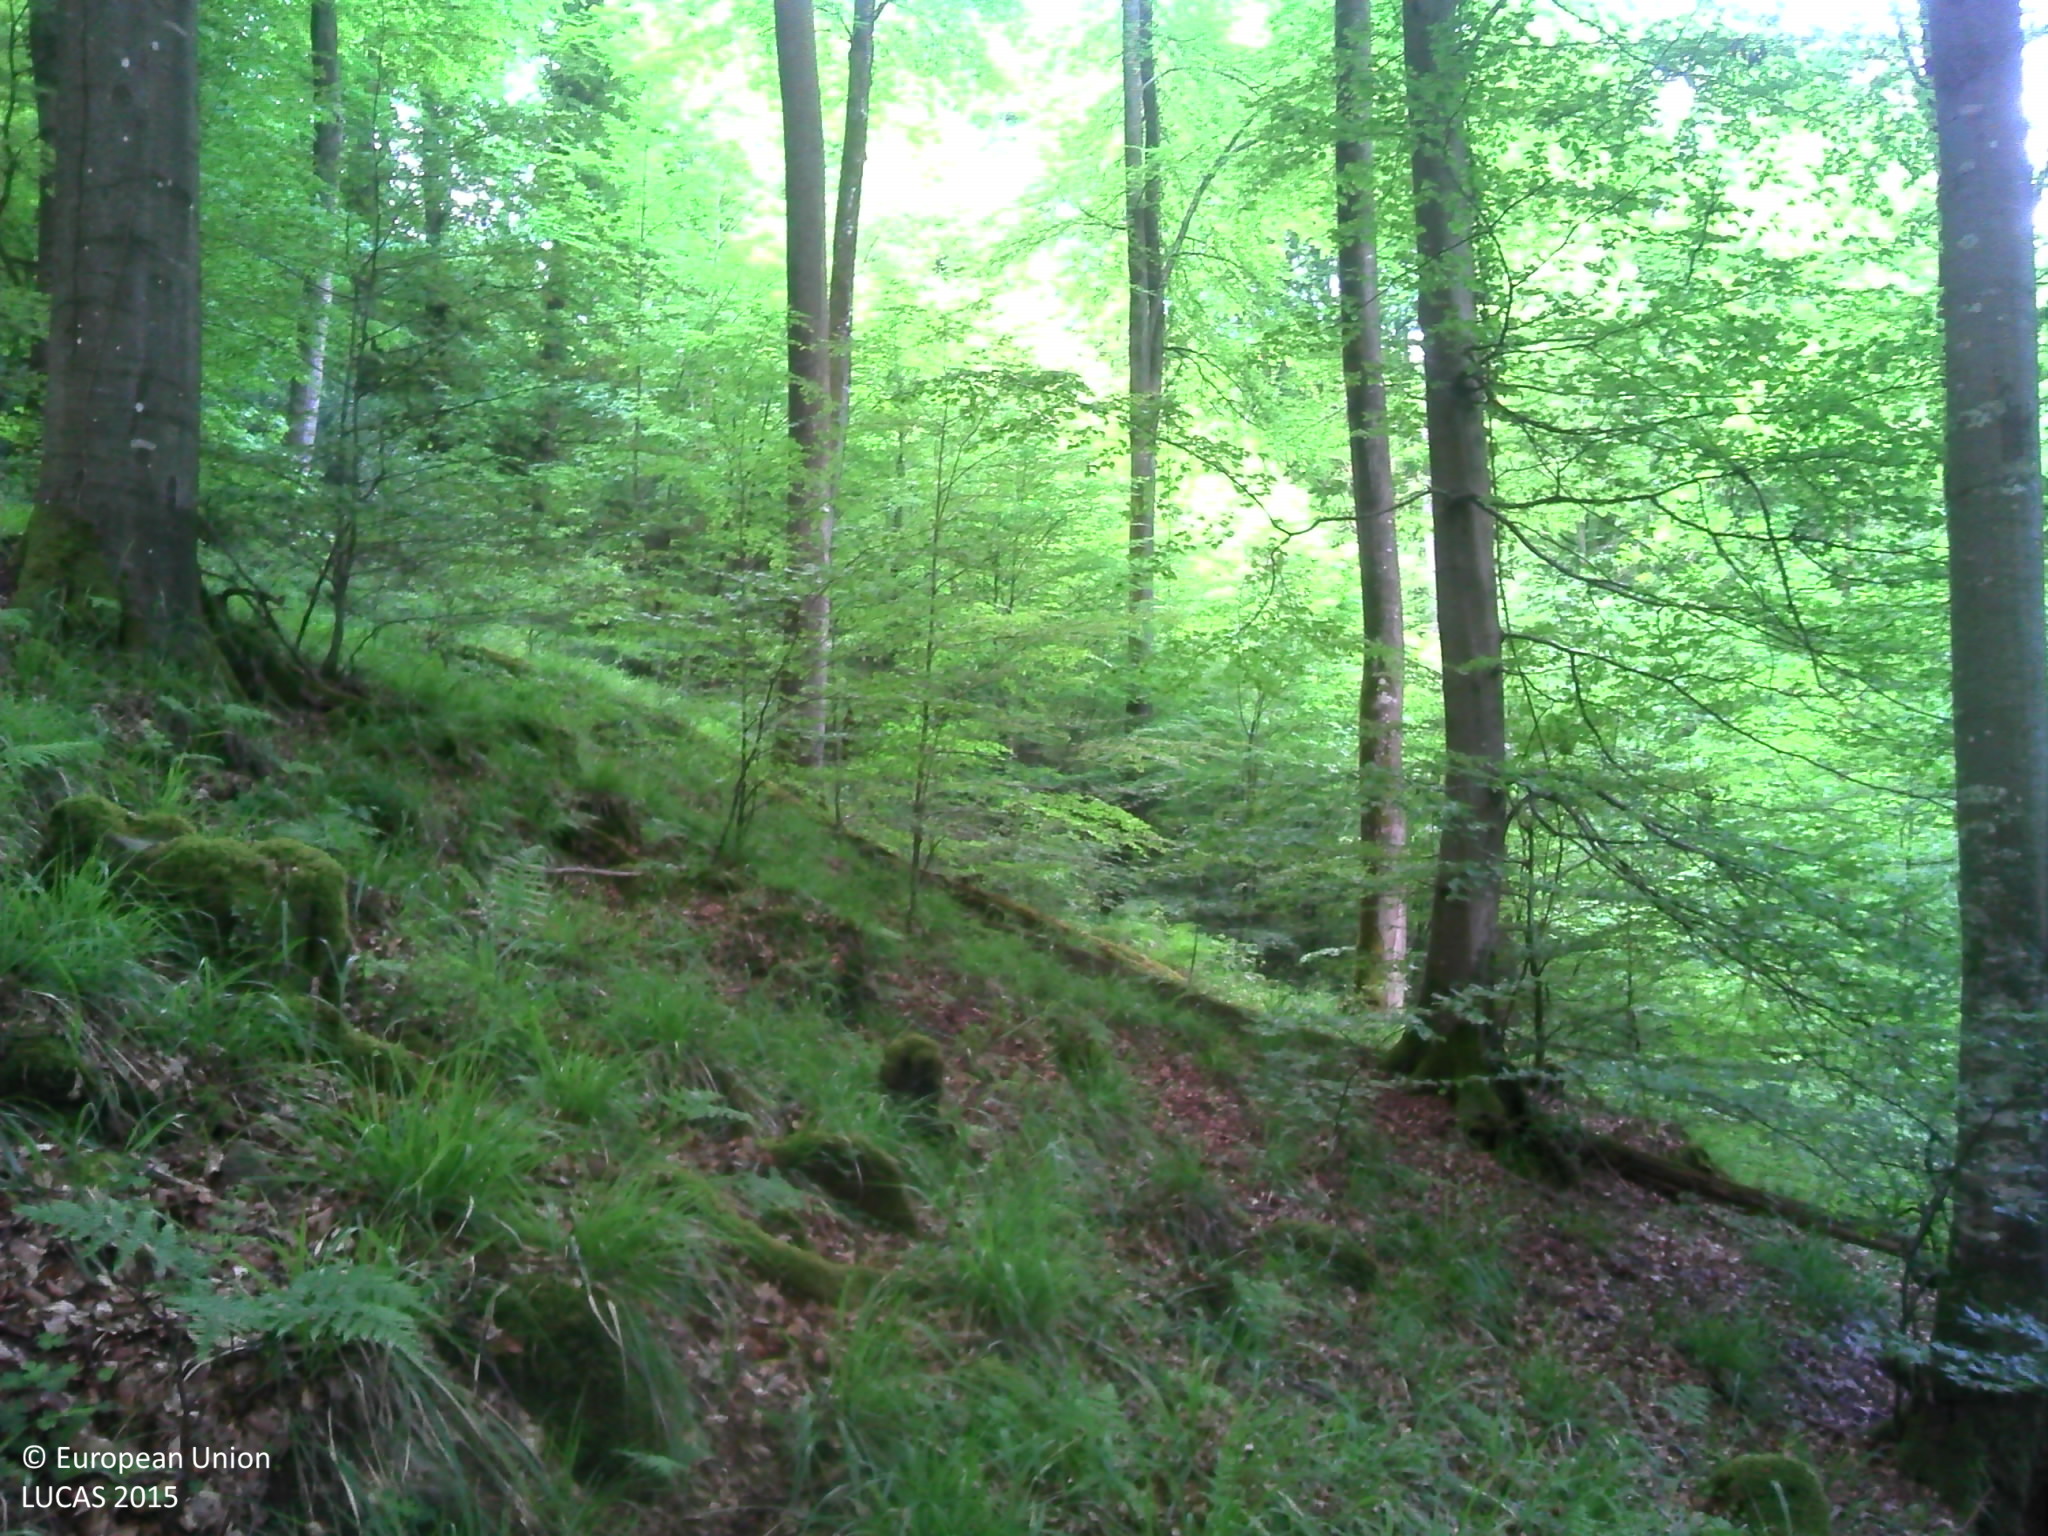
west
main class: Woodland
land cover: Broadleaved woodland
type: acidophilous oak and oak-birch forest
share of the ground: > 75 %
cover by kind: broadleaved forest trees 75 %, herbaceous plants 20 %, lichens and mosses 5 %
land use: Forestry
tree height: > 5 m
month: May
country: LU
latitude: 49.8385
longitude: 6.3706
